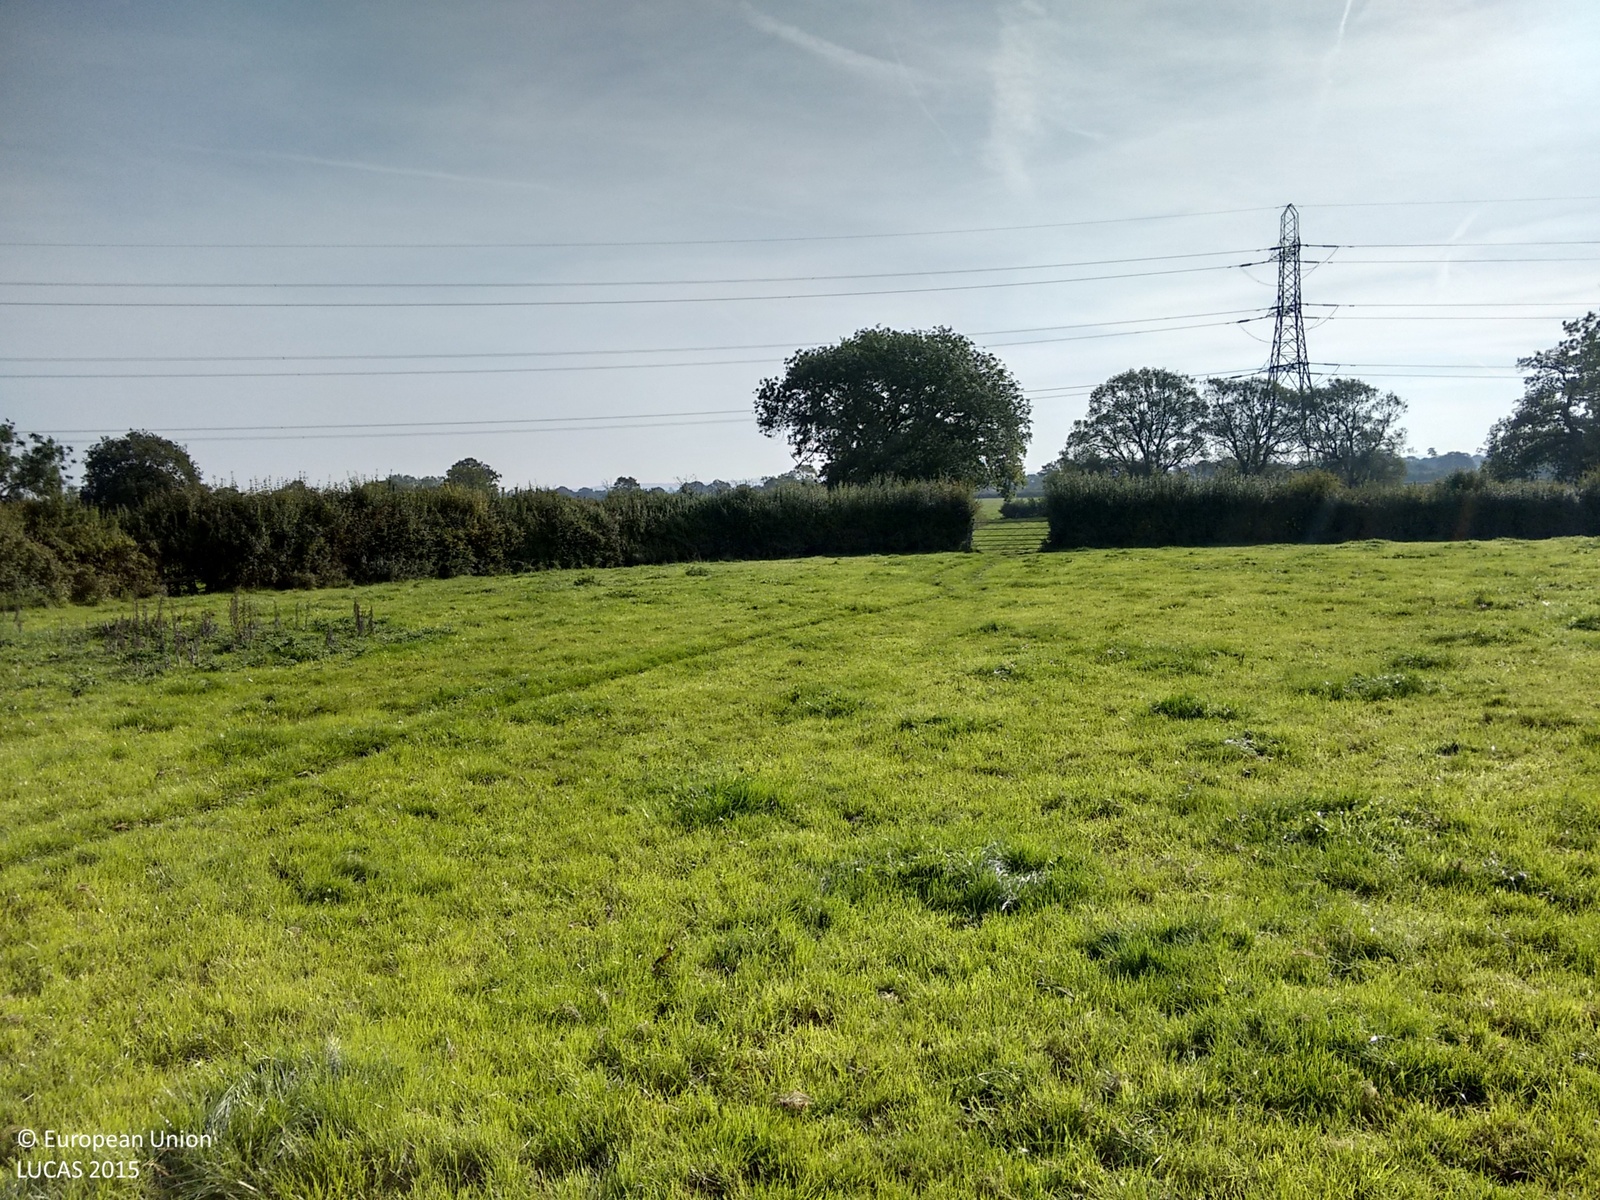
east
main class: Grassland
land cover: Grassland without tree/shrub cover
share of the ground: > 75 %
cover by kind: herbaceous plants 100 %
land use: Agriculture (excluding fallow land and kitchen gardens)
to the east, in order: Grassland without tree/shrub cover; Fences; Managed hedges; Fences; Grassland without tree/shrub cover; Fences; Managed hedges; Rivers and streams; Fences; Grassland without tree/shrub cover; Electric lines; Grassland without tree/shrub cover
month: September
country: GB
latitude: 51.5899
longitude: -2.4647
